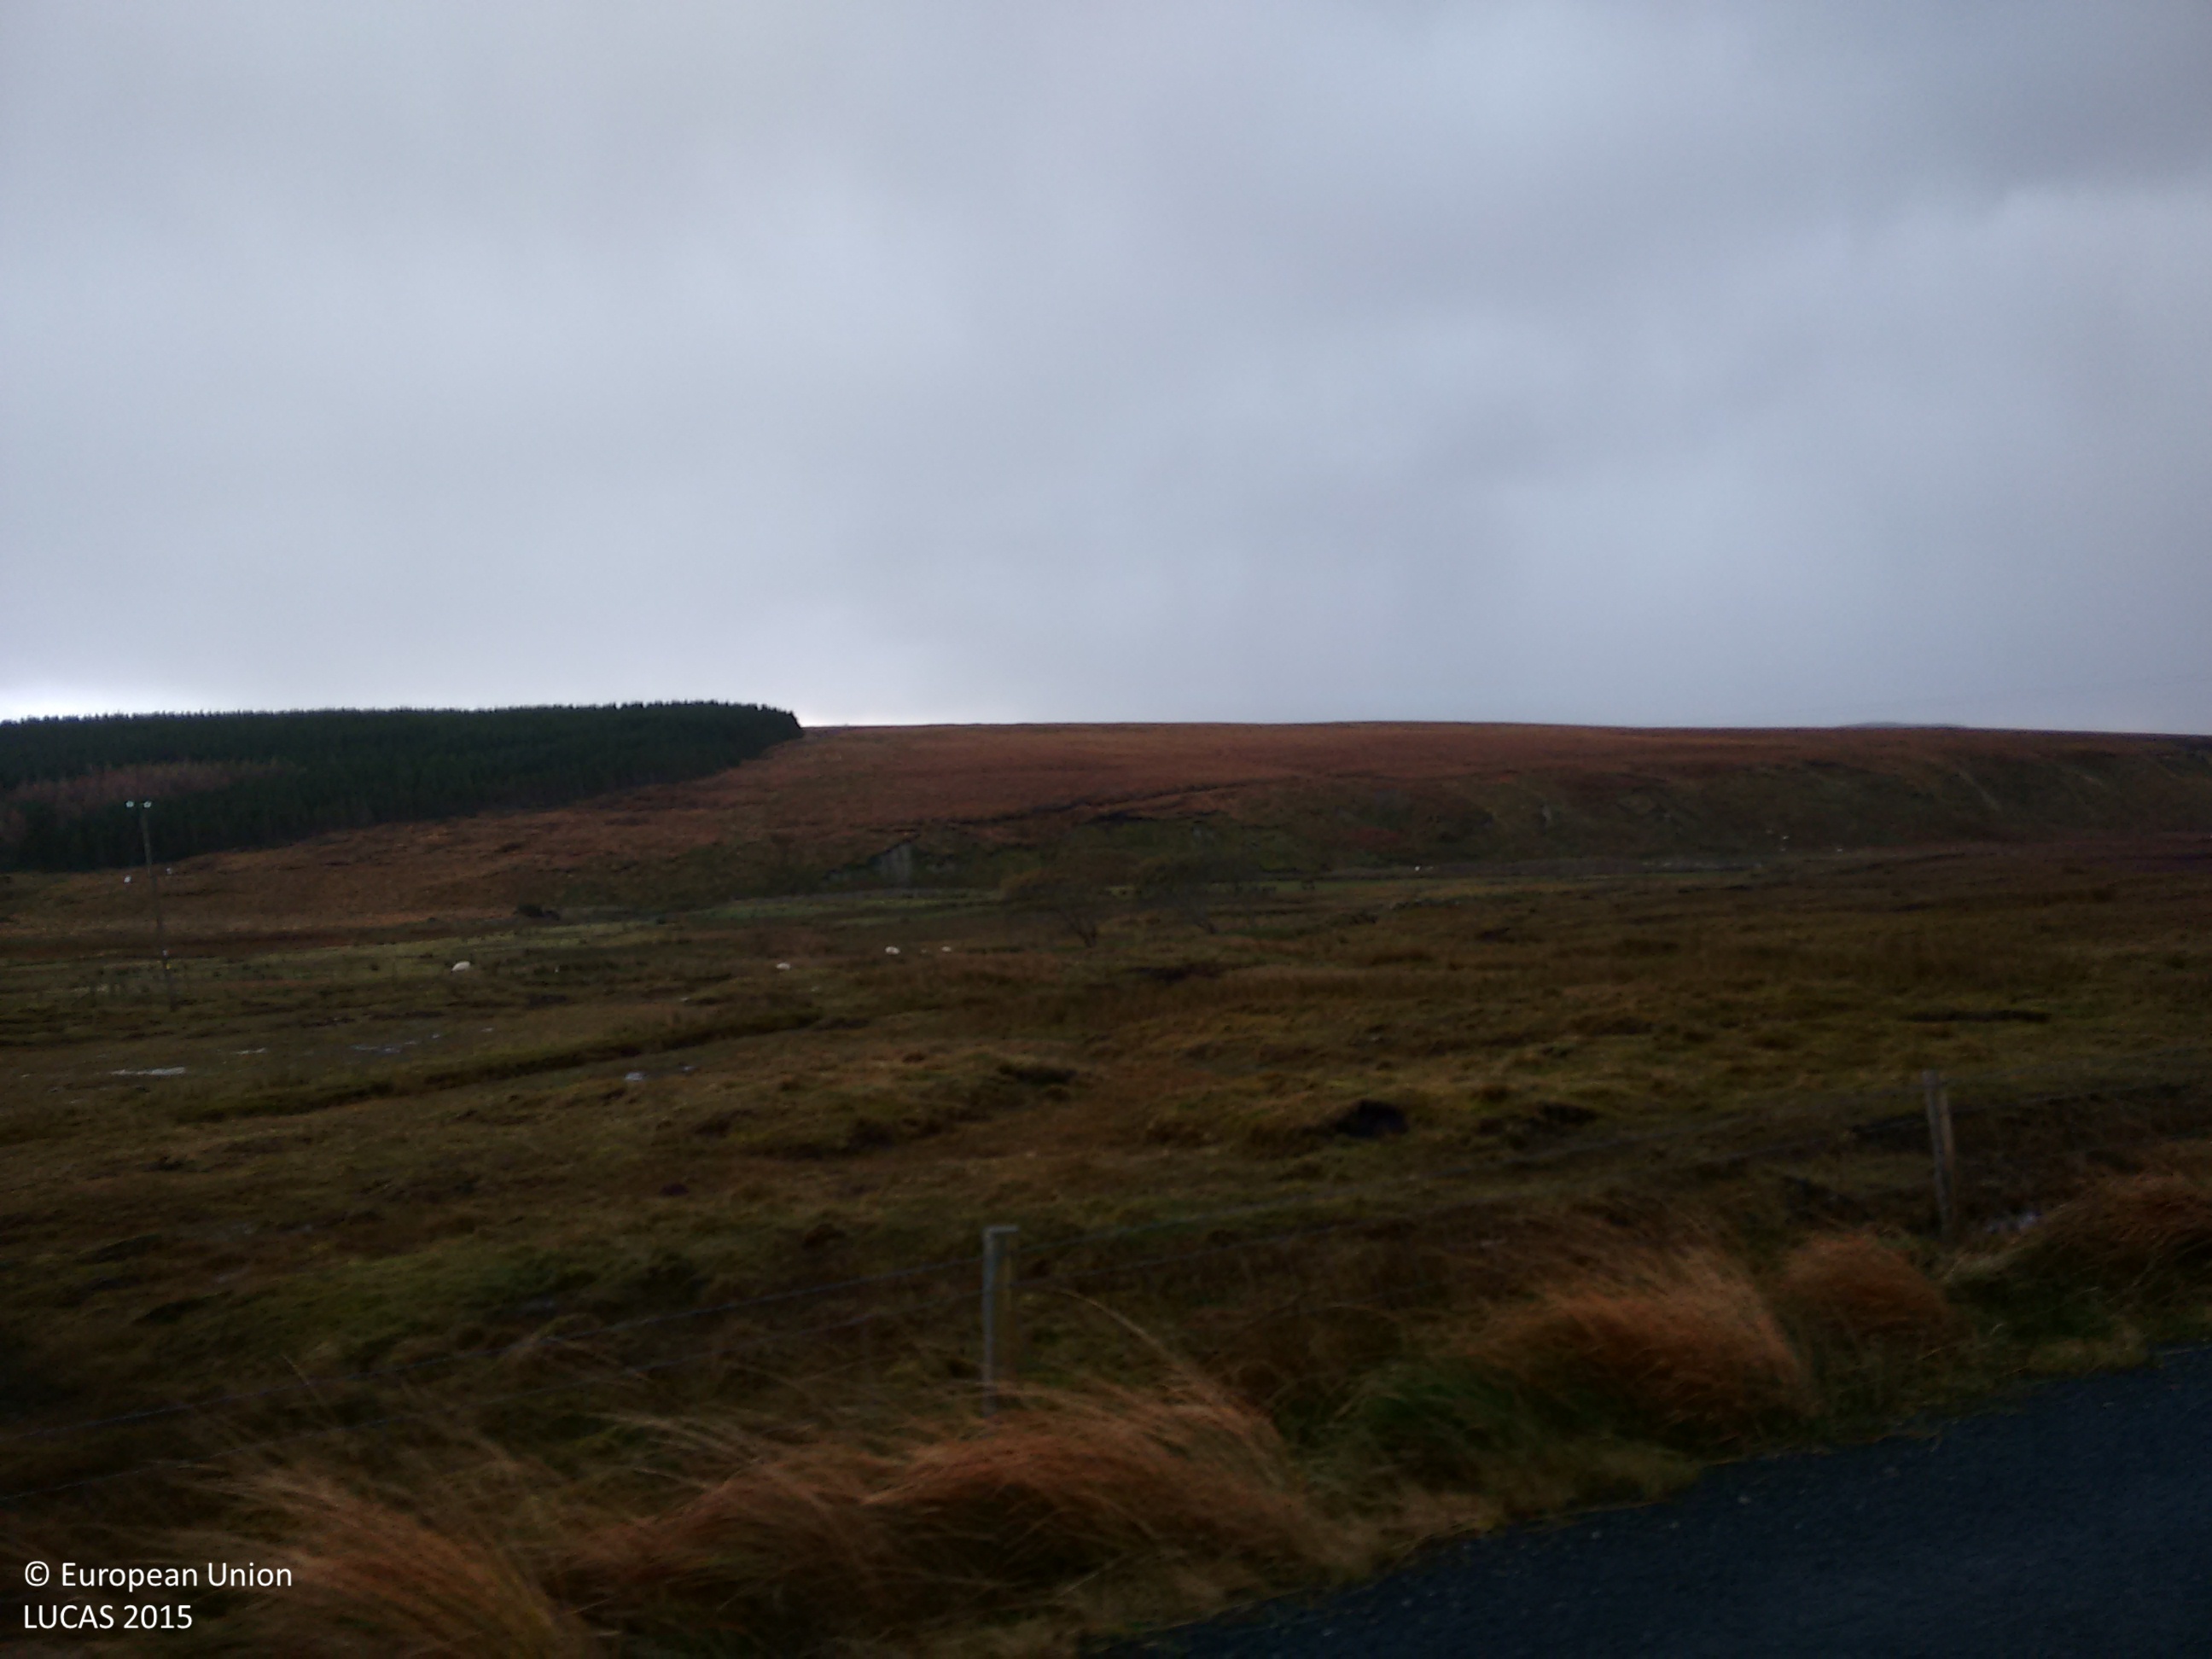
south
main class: Grassland
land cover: Grassland without tree/shrub cover
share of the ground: > 75 %
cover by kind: herbaceous plants 100 %
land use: Agriculture (excluding fallow land and kitchen gardens)
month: November
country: IE
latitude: 54.7174
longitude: -8.5898
